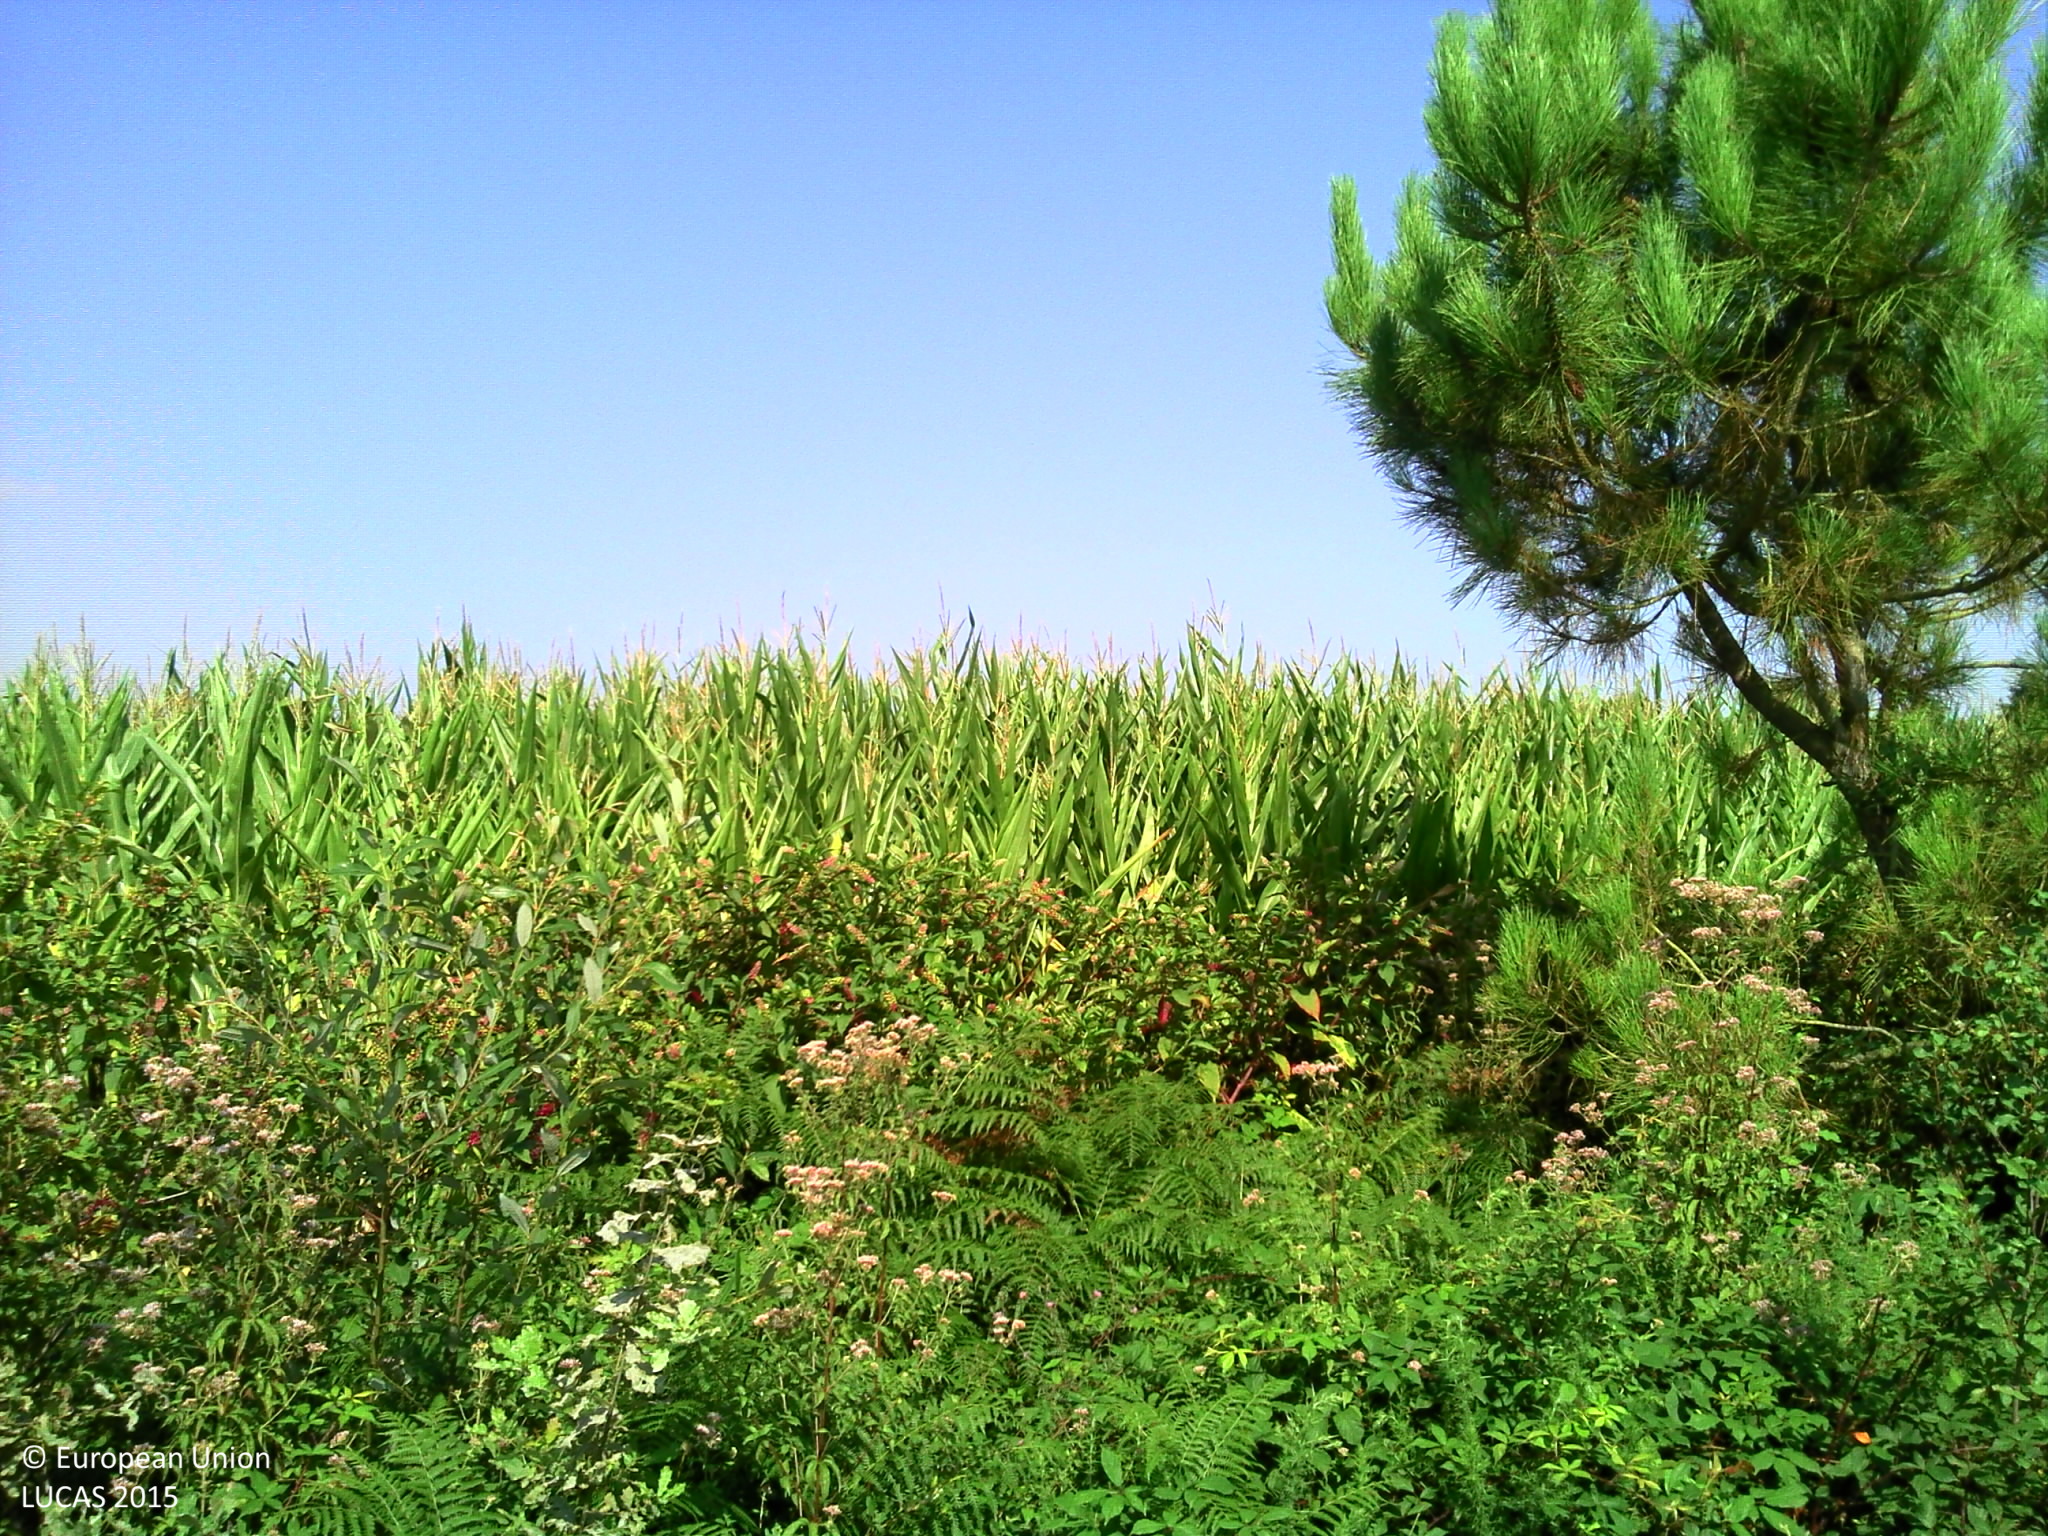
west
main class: Cropland
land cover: Maize
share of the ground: > 75 %
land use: Agriculture (excluding fallow land and kitchen gardens)
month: August
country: FR
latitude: 43.7918
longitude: -0.5627
